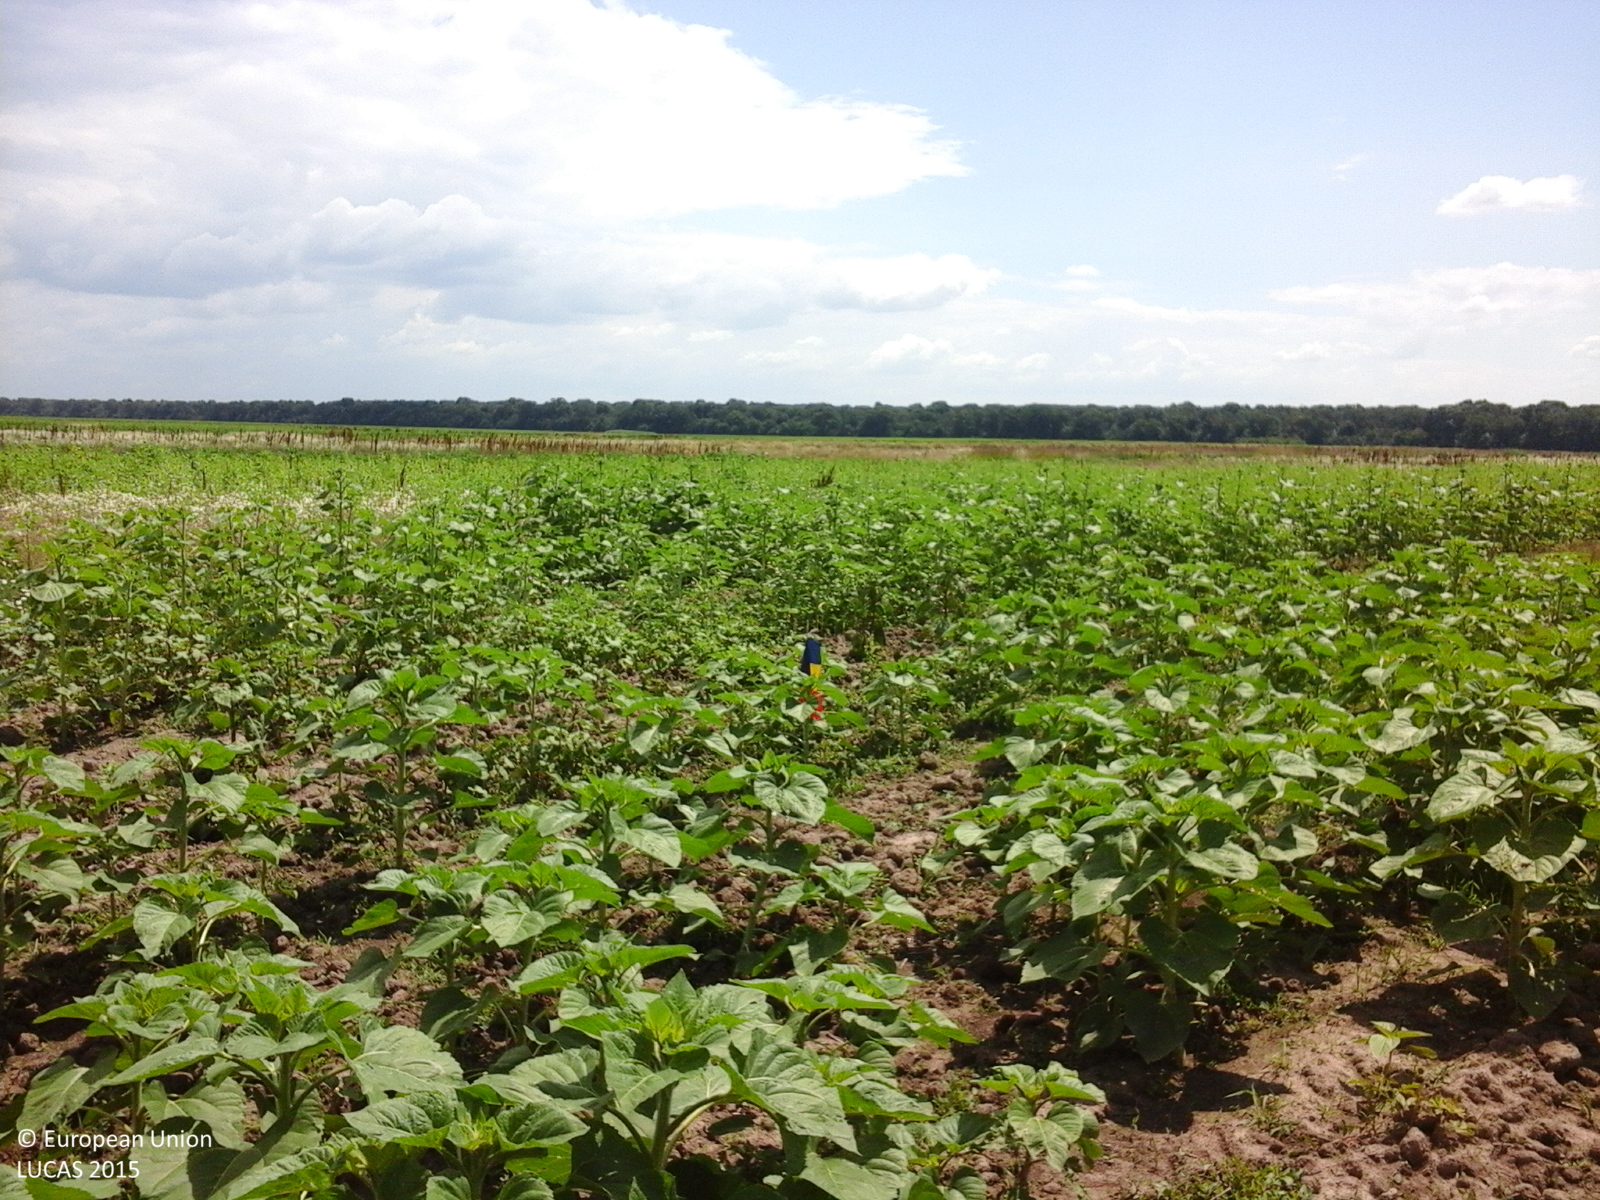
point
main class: Cropland
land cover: Sunflower
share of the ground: 50 - 75 %
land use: Agriculture (excluding fallow land and kitchen gardens)
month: July
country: RO
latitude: 44.3914
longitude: 25.5967
